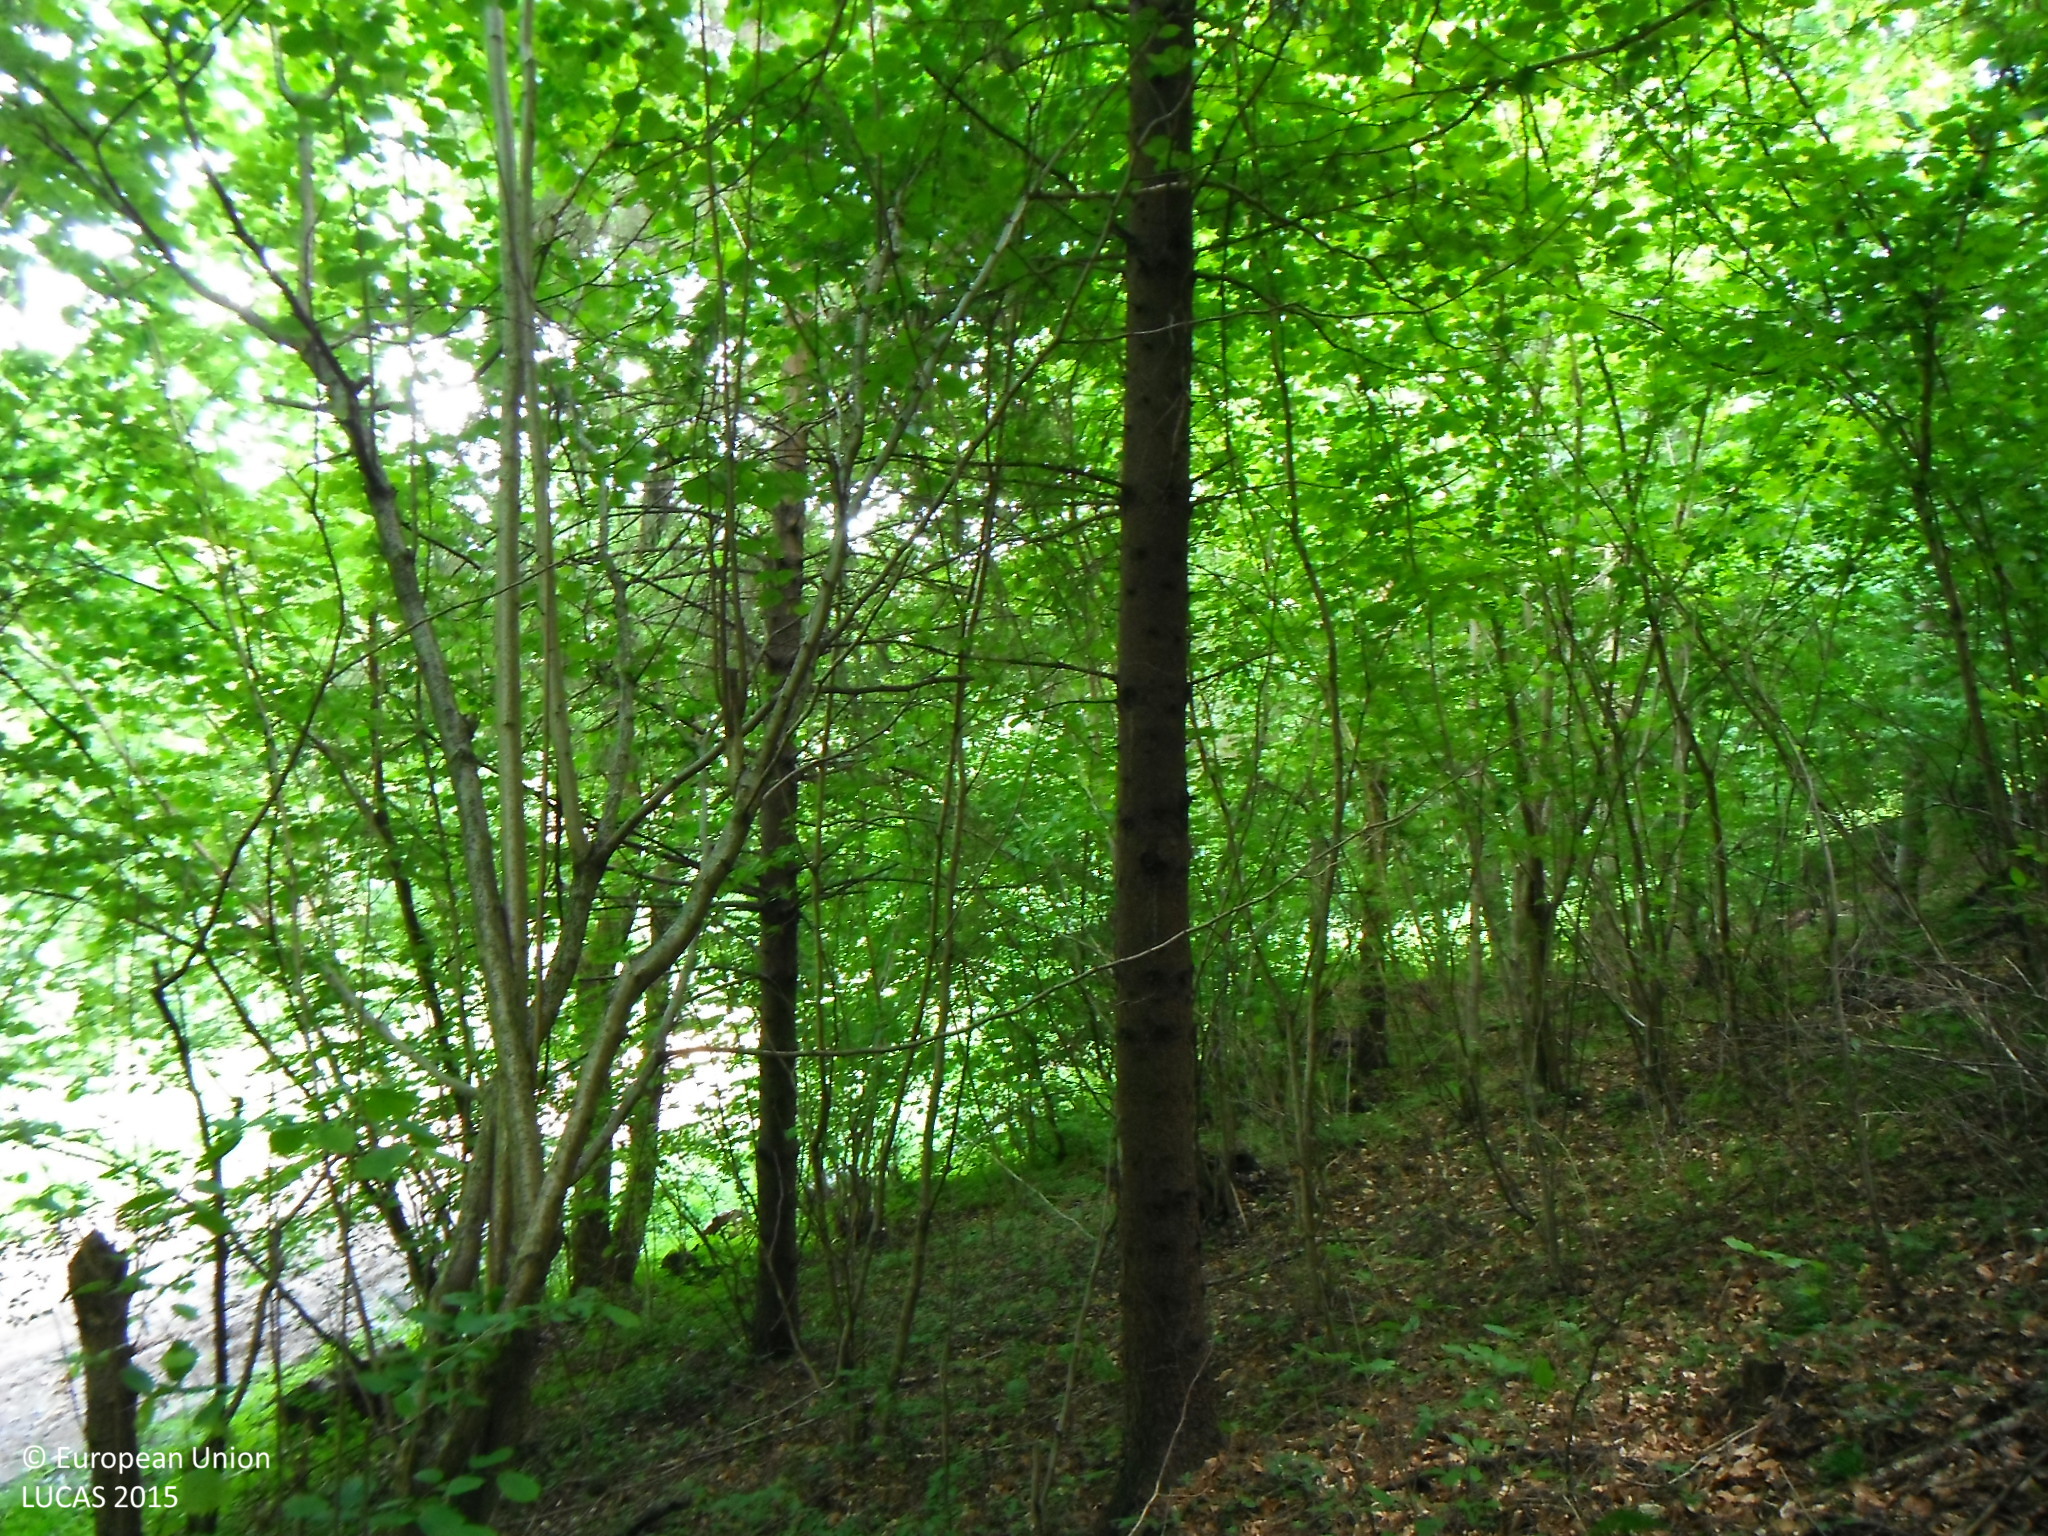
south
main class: Woodland
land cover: Other mixed woodland
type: hemiboreal forest and nemoral coniferous forest and mixed broadleaved-coniferous forest
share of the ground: > 75 %
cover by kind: broadleaved forest trees 60 %, coniferous forest trees 40 %
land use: Forestry
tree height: > 5 m
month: June
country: SK
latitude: 48.8982
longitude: 21.0783
